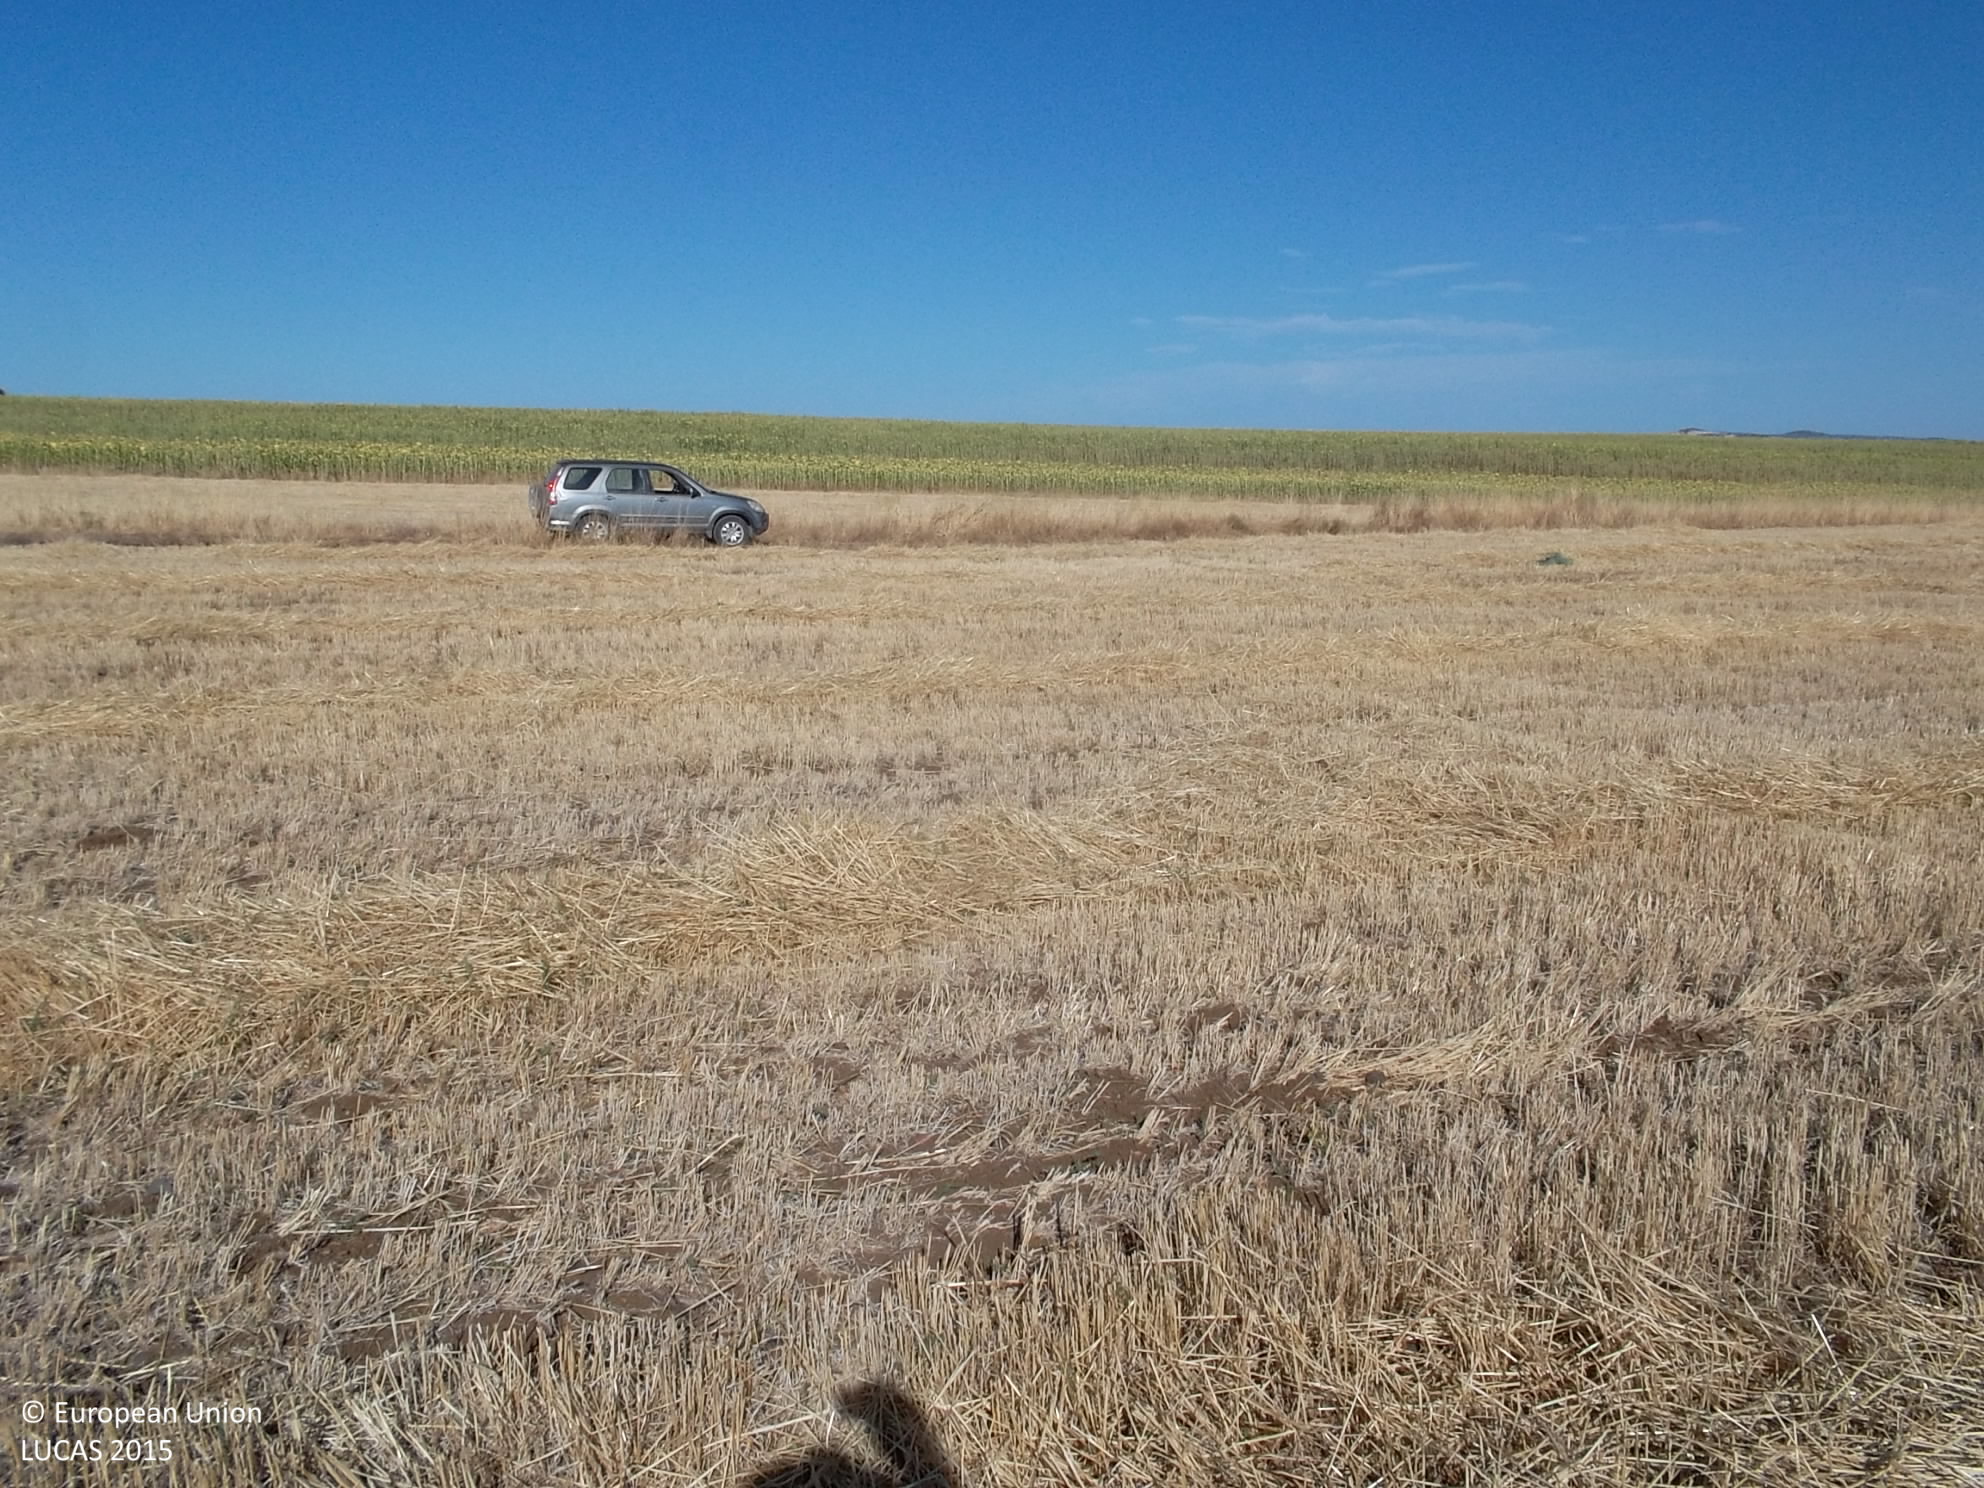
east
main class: Cropland
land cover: Barley
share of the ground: < 10 %
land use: Agriculture (excluding fallow land and kitchen gardens)
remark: Harvested field
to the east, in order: Barley; Grass margins; Tracks; Grass margins; Barley; Grass margins; Sunflower; Grass margins; Sunflower; Grass margins; Sunflower
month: July
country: ES
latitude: 38.3008
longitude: -5.6663
